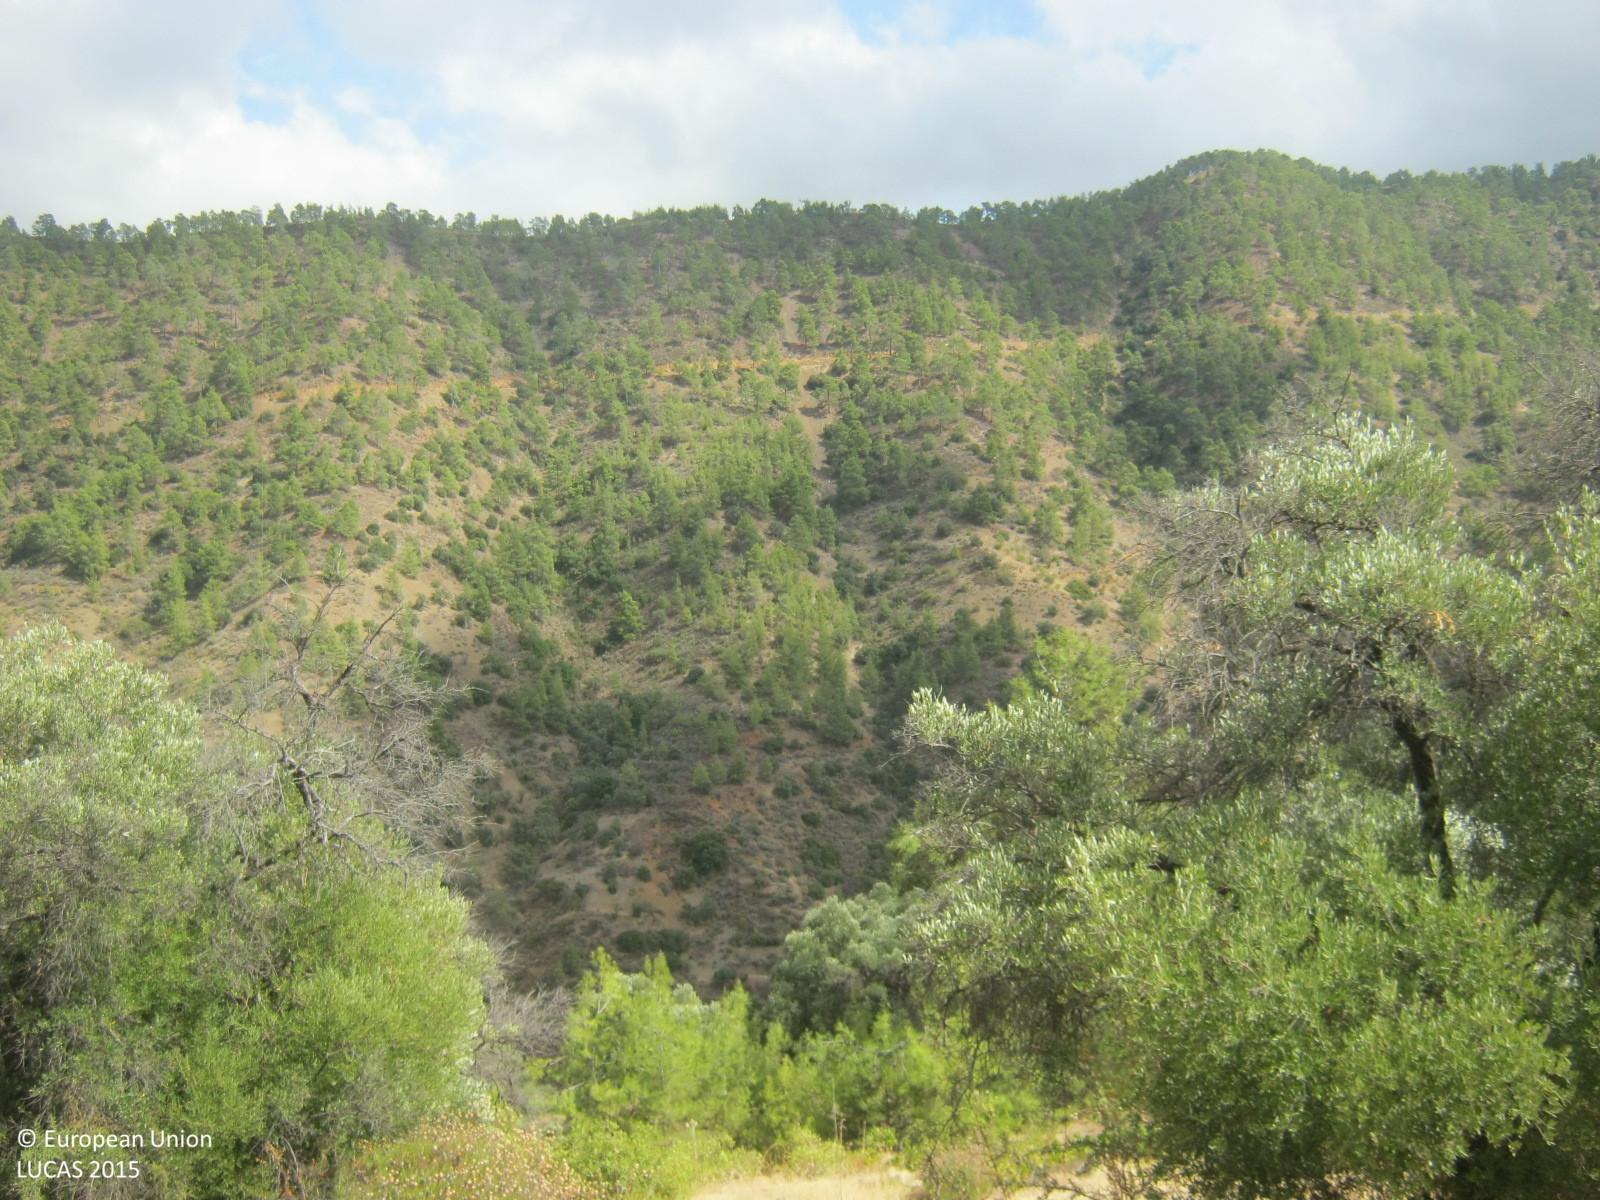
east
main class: Woodland
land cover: Other mixed woodland
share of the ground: 25 - 50 %
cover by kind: shrubs 30 %, herbaceous plants 30 %, broadleaved forest trees 25 %, coniferous forest trees 15 %
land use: Semi-natural and natural areas not in use
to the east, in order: Other mixed woodland; Shrubland without tree cover; Olive groves; Dry stone walls; Pine dominated coniferous woodland; Olive groves
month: September
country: CY
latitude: 35.0265
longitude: 32.8228
